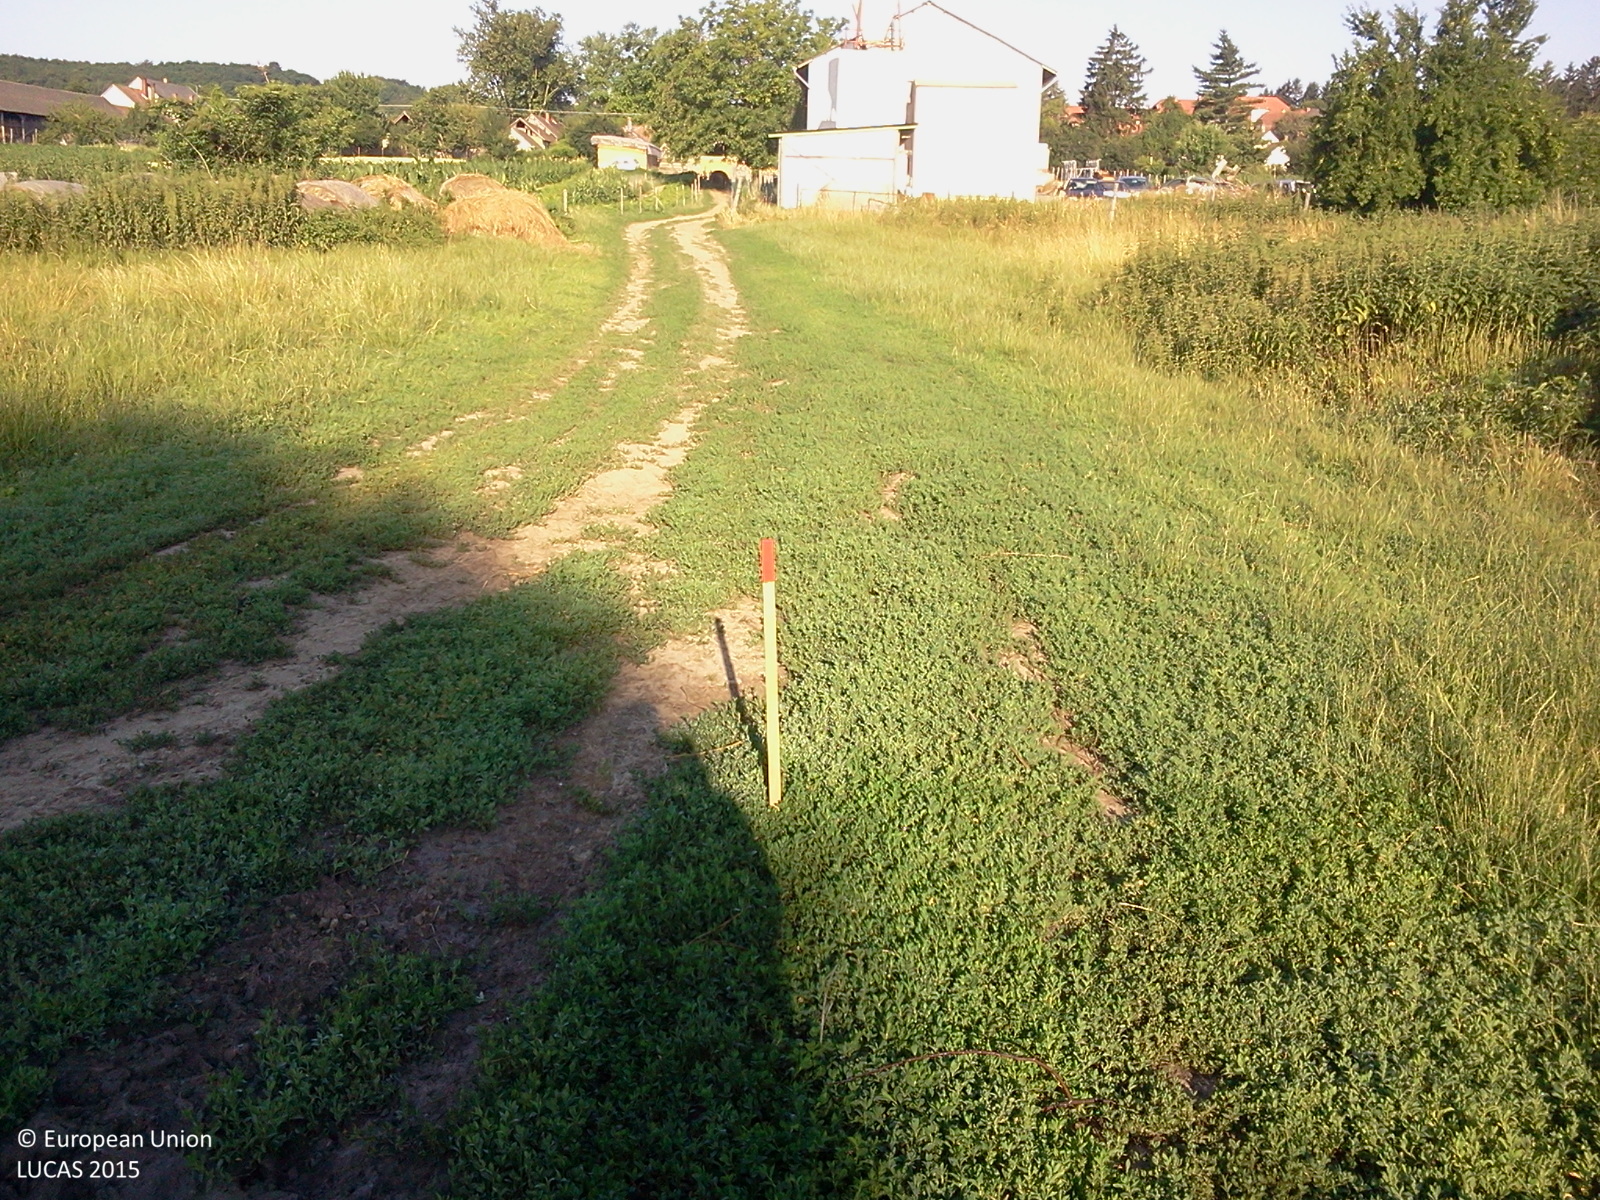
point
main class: Grassland
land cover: Spontaneously vegetated surfaces
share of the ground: > 75 %
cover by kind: herbaceous plants 100 %
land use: Agriculture (excluding fallow land and kitchen gardens)
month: June
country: HU
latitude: 46.7291
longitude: 17.1093
